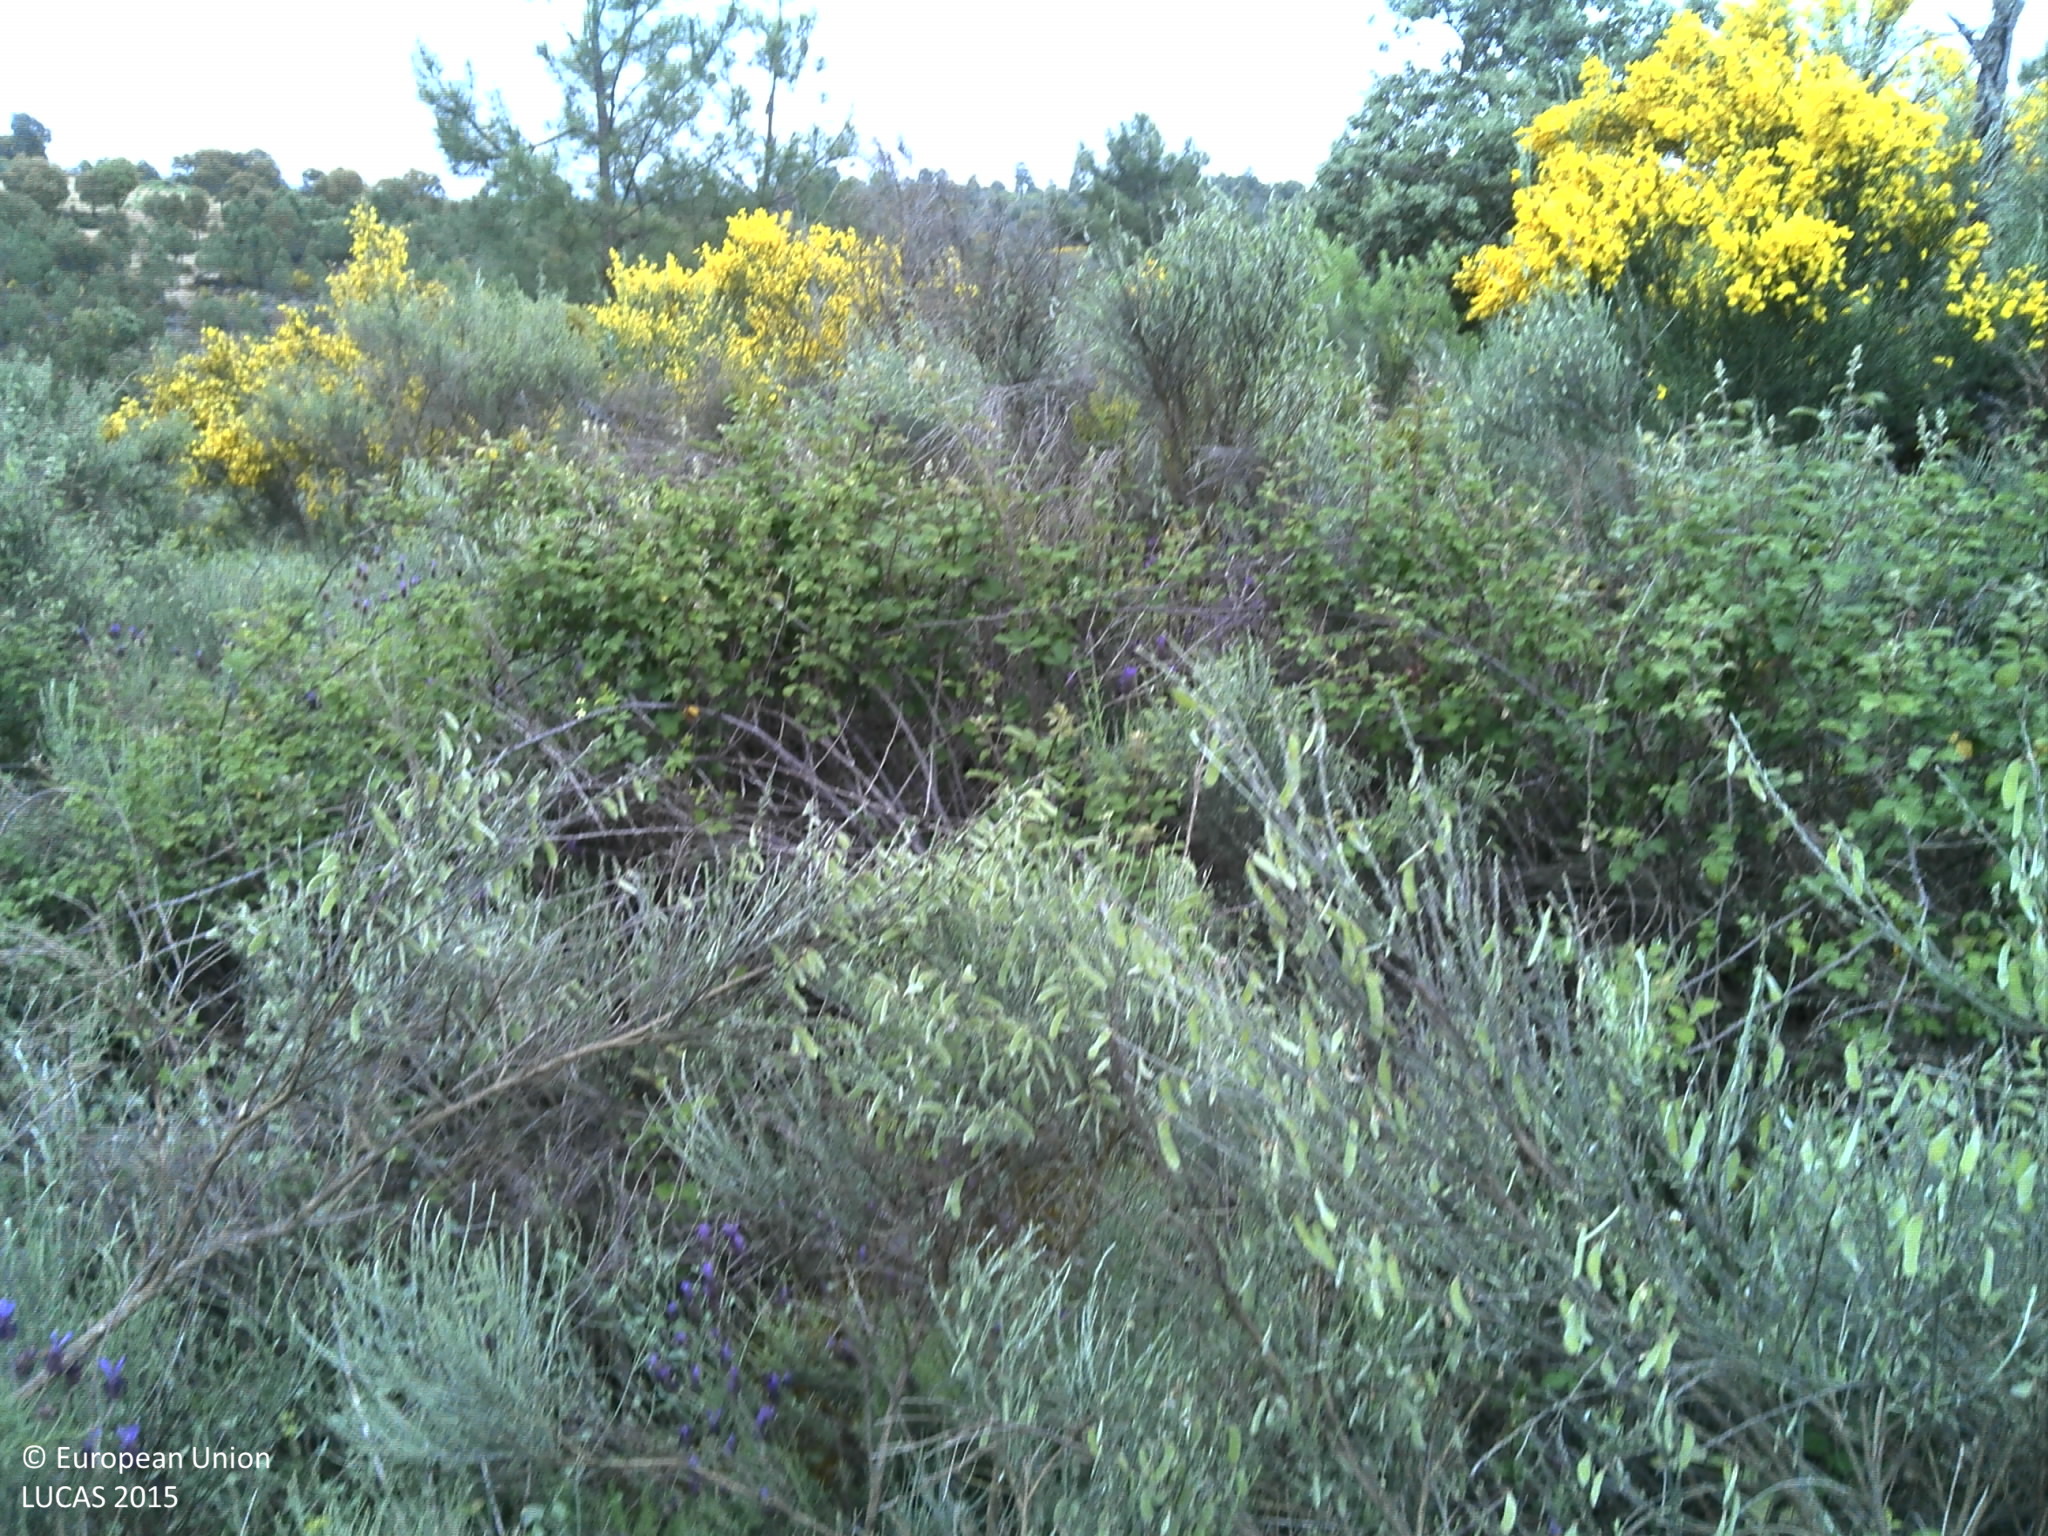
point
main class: Shrubland
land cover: Shrubland with sparse tree cover
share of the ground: > 75 %
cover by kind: shrubs 90 %, broadleaved forest trees 5 %, unconsolidated bare surface 5 %
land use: Abandoned areas
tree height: > 5 m
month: May
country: PT
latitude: 41.6731
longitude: -7.1656
